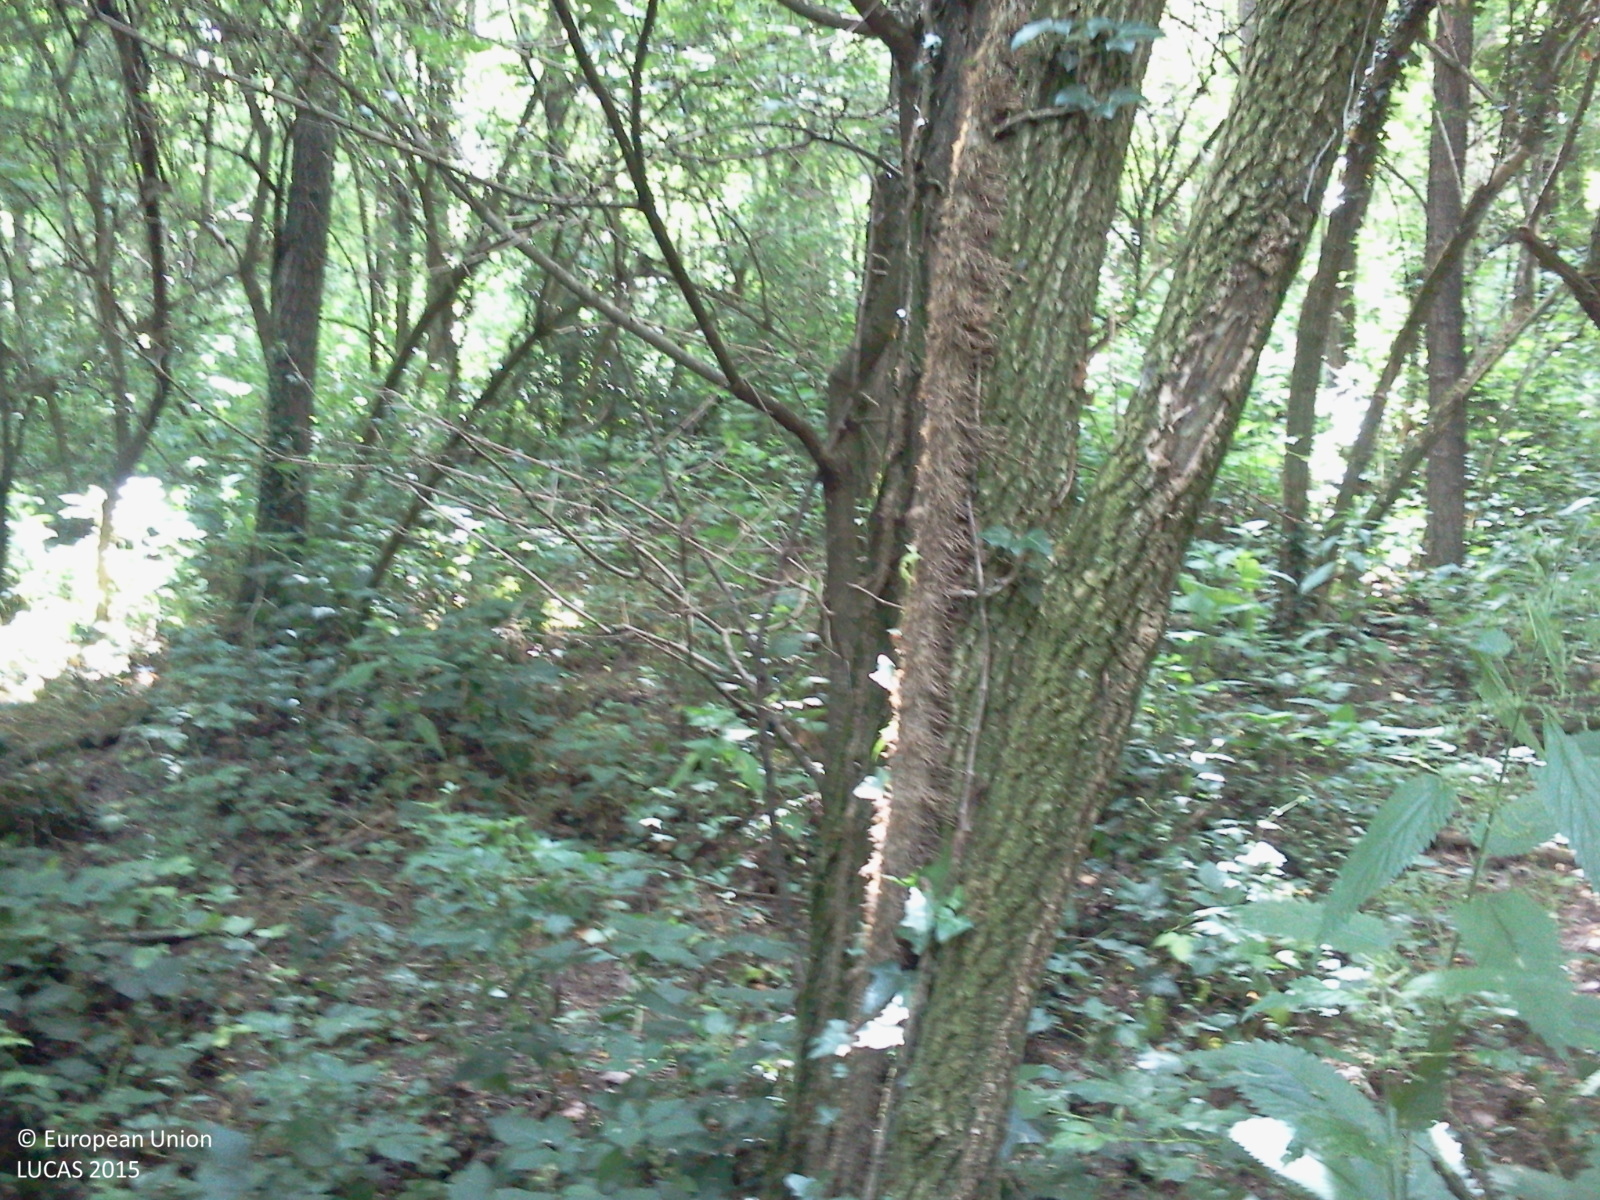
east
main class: Woodland
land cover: Broadleaved woodland
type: hemiboreal forest and nemoral coniferous forest and mixed broadleaved-coniferous forest
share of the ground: > 75 %
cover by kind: broadleaved forest trees 90 %, shrubs 10 %
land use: Forestry
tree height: > 5 m
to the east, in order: Broadleaved woodland
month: June
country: HU
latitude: 46.8793
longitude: 17.0242
